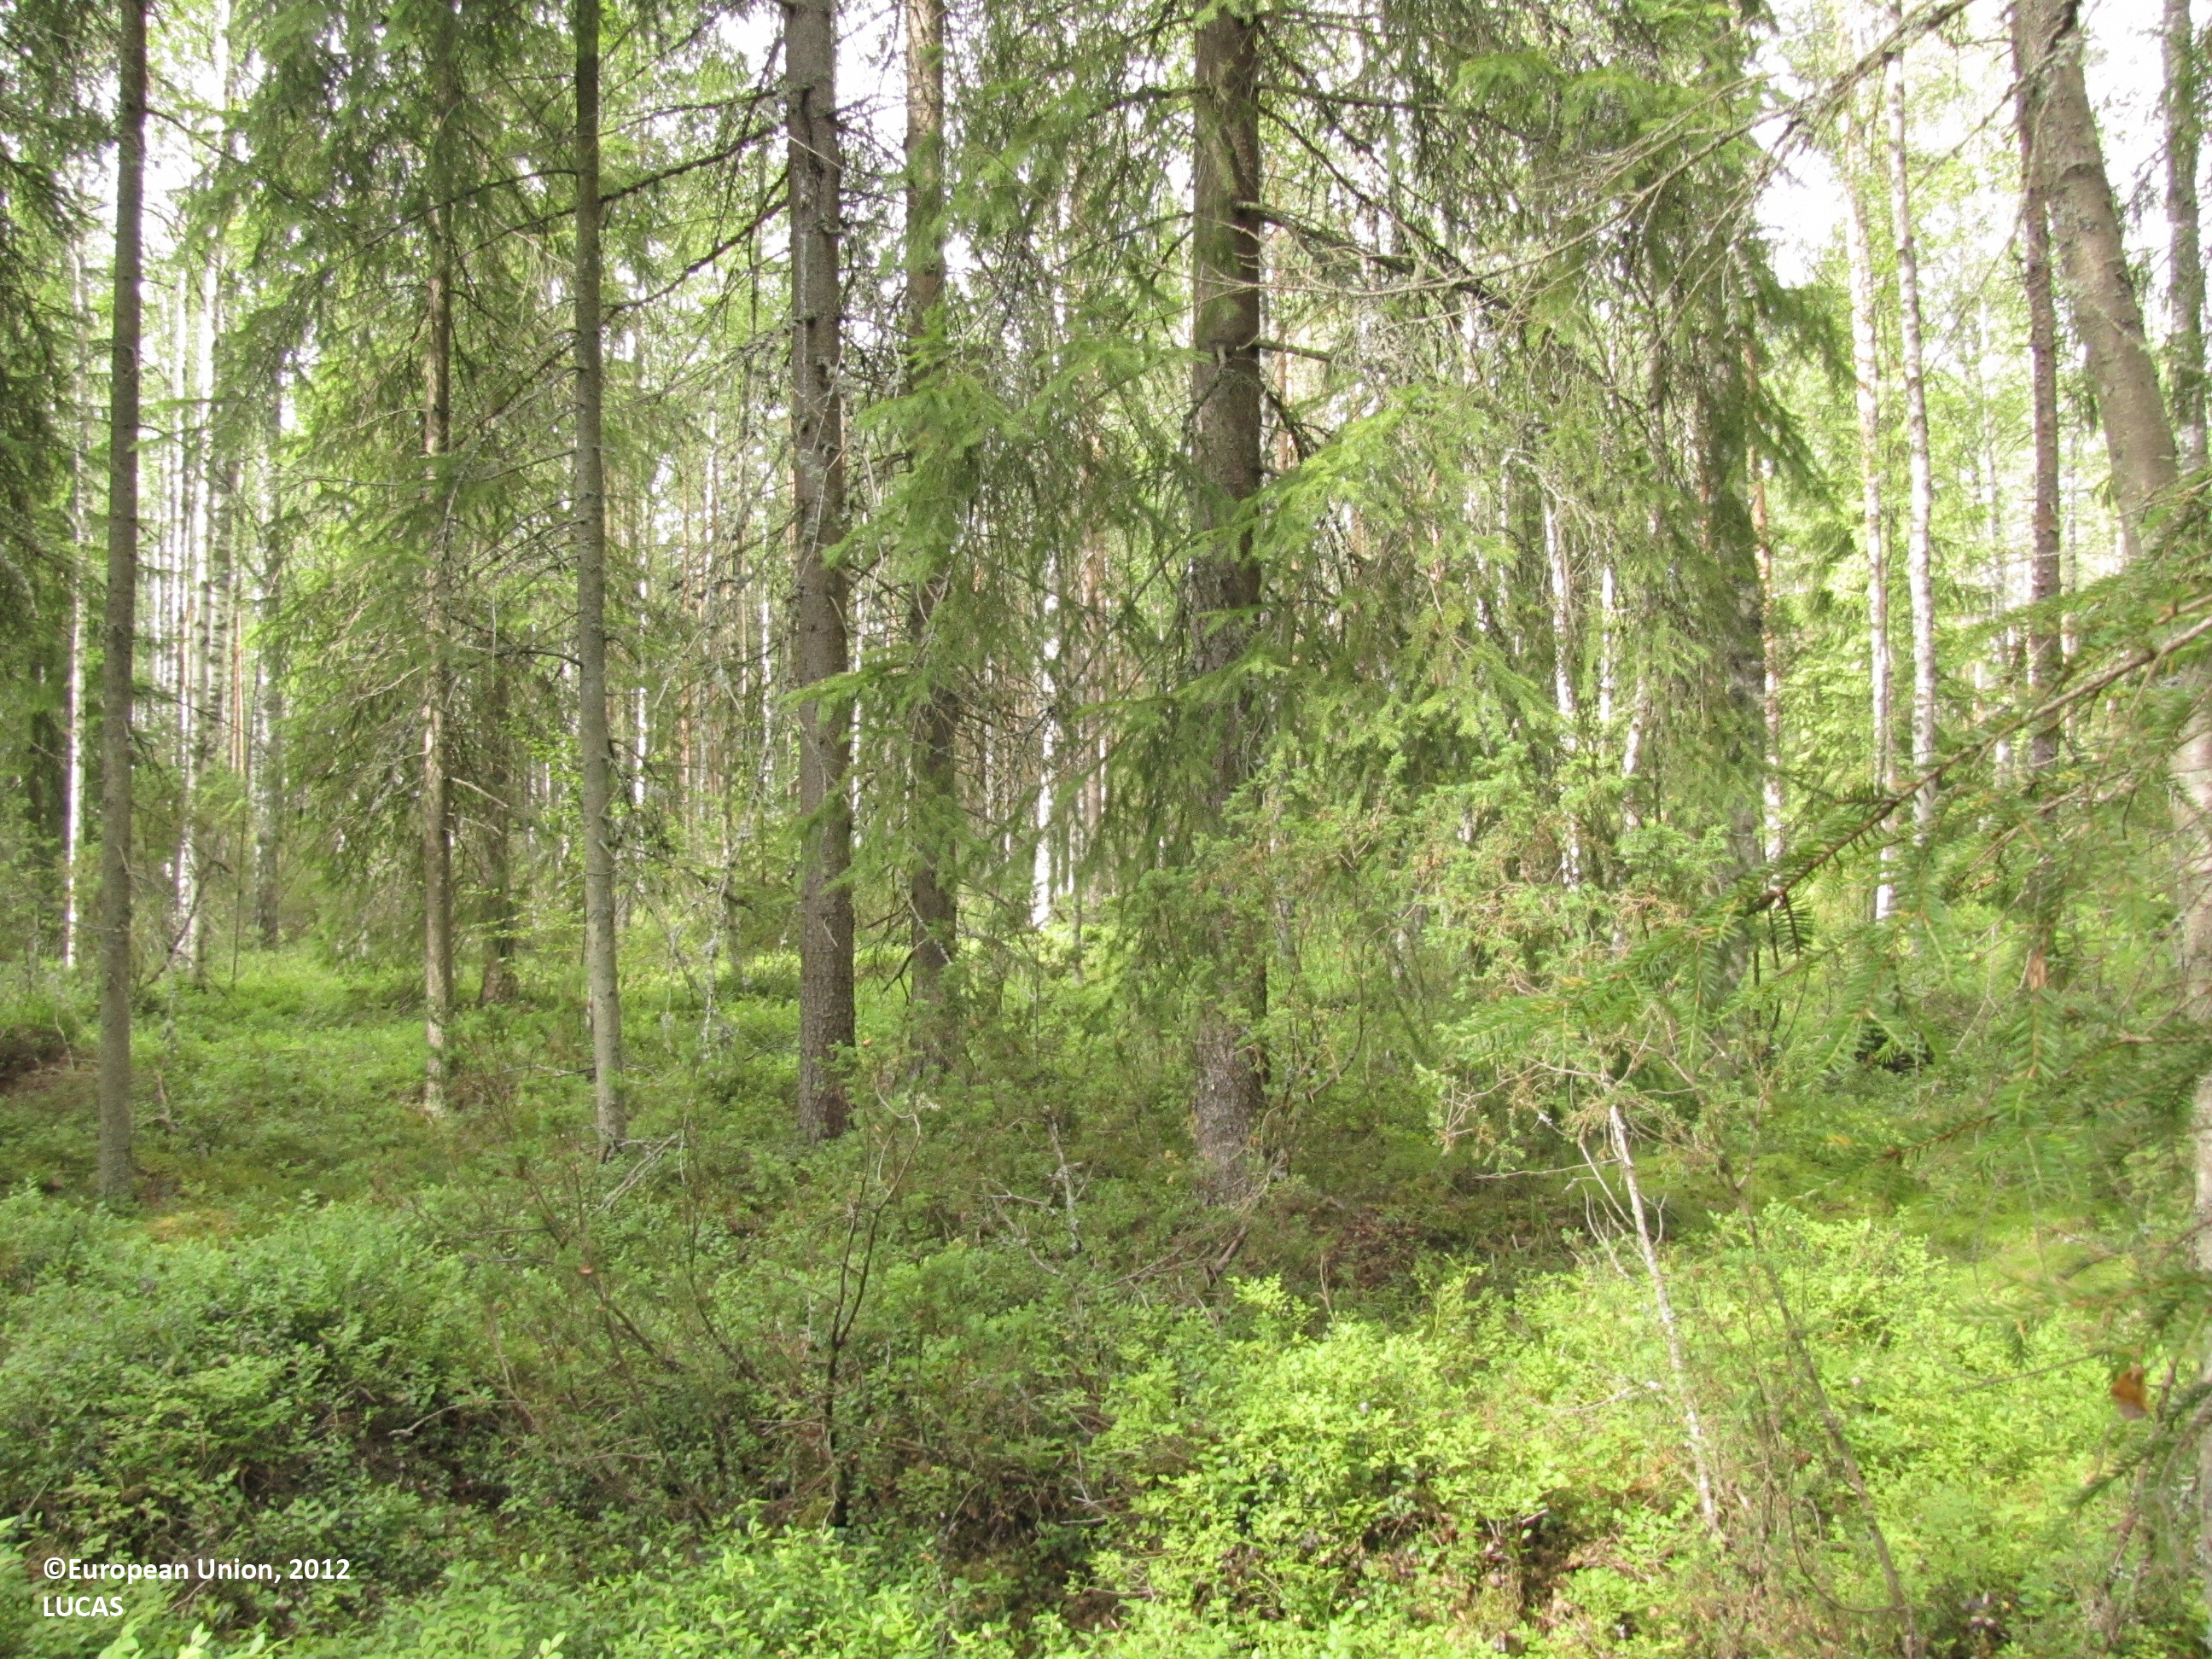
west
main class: Woodland
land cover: Other mixed woodland
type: boreal forest
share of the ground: > 75 %
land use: Forestry
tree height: > 5 m
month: July
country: FI
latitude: 62.6363
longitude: 22.9517
